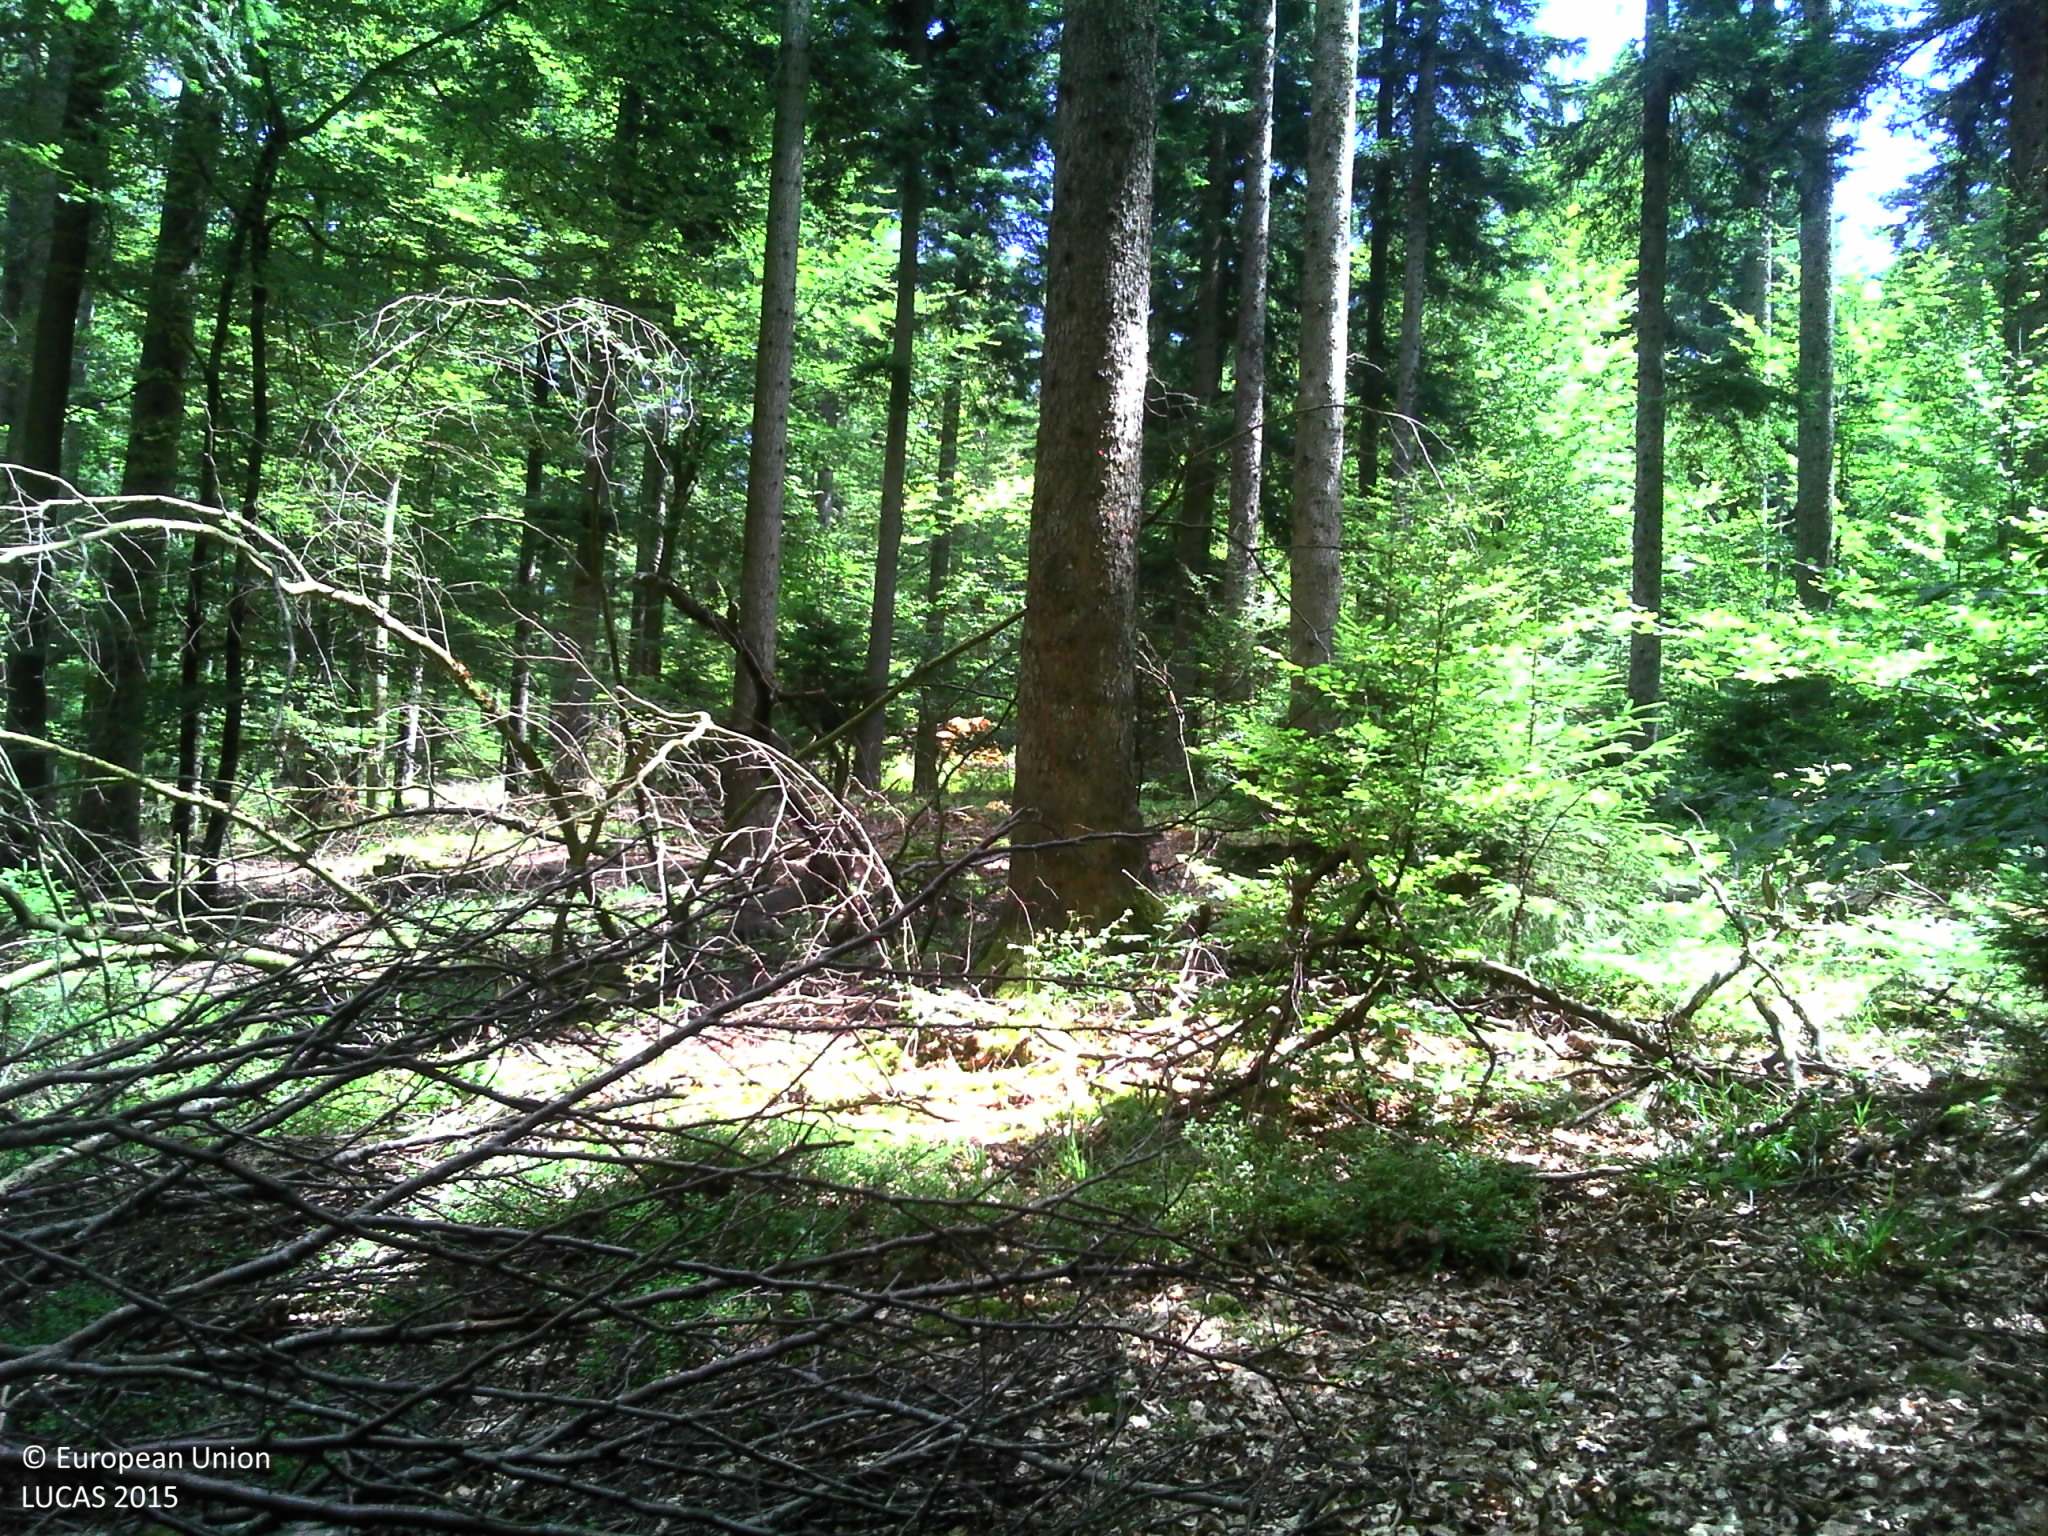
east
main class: Woodland
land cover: Spruce dominated mixed woodland
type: mountainous beech forest
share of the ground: > 75 %
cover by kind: broadleaved forest trees 60 %, coniferous forest trees 40 %
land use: Forestry
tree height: > 5 m
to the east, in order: Spruce dominated mixed woodland; Tracks; Spruce dominated mixed woodland
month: July
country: FR
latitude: 48.5873
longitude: 7.3300
